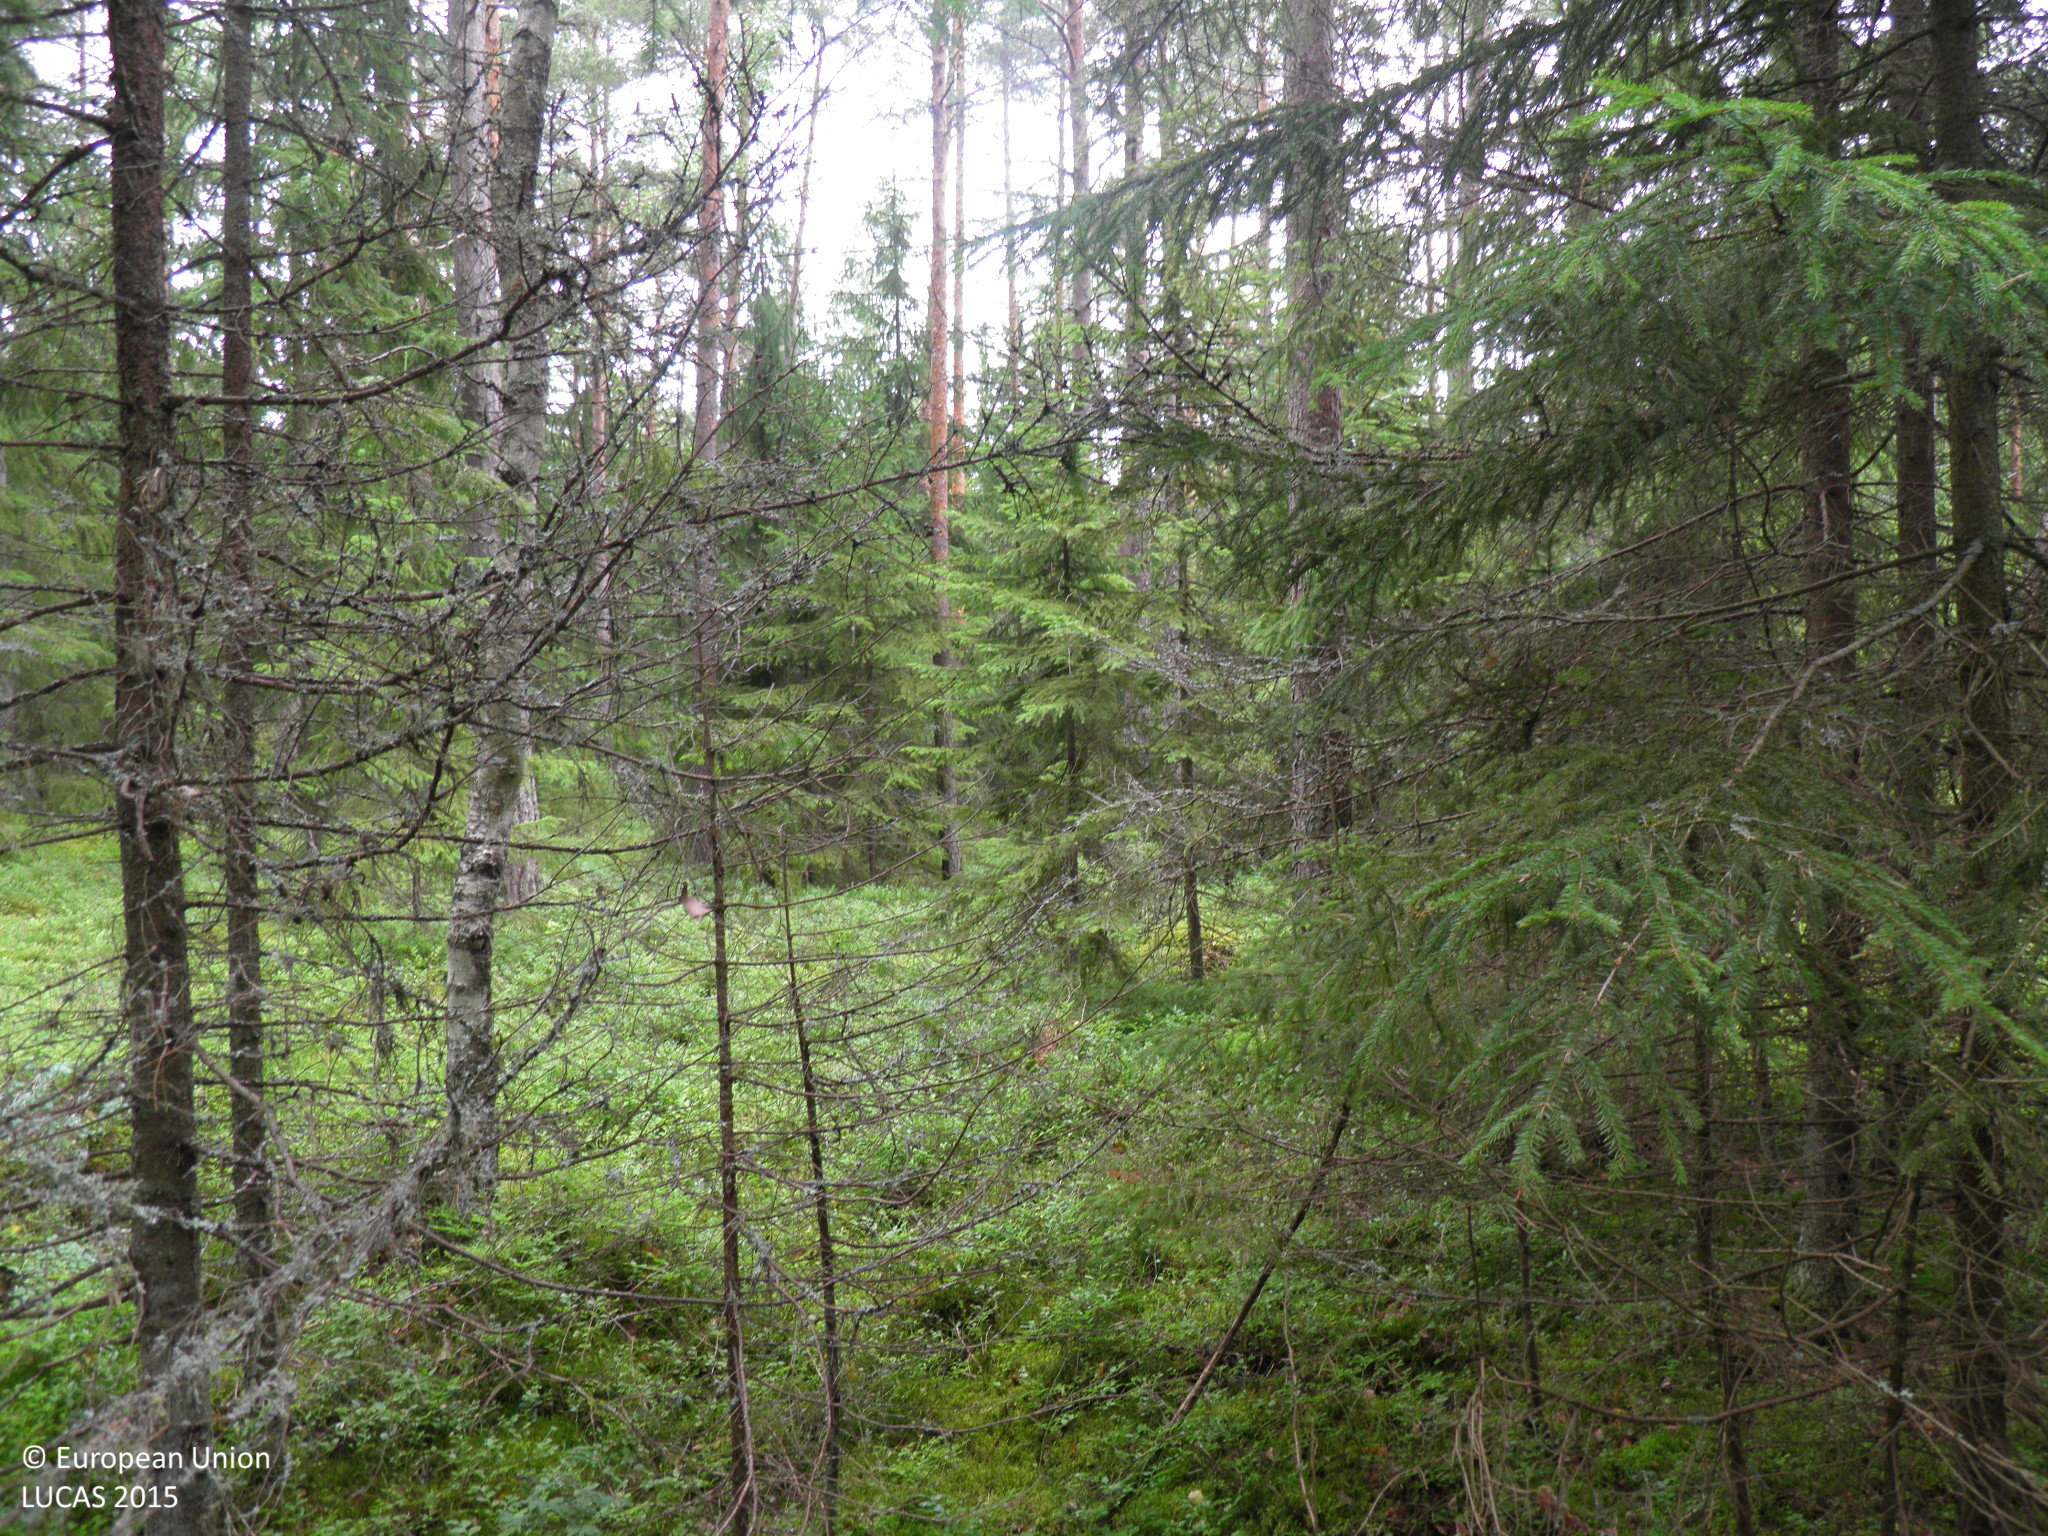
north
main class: Woodland
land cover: Pine dominated coniferous woodland
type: hemiboreal forest and nemoral coniferous forest and mixed broadleaved-coniferous forest
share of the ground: 50 - 75 %
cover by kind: coniferous forest trees 50 %, shrubs 30 %, broadleaved forest trees 10 %, lichens and mosses 10 %
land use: Forestry
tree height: > 5 m
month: July
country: FI
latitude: 60.6216
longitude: 21.4769
